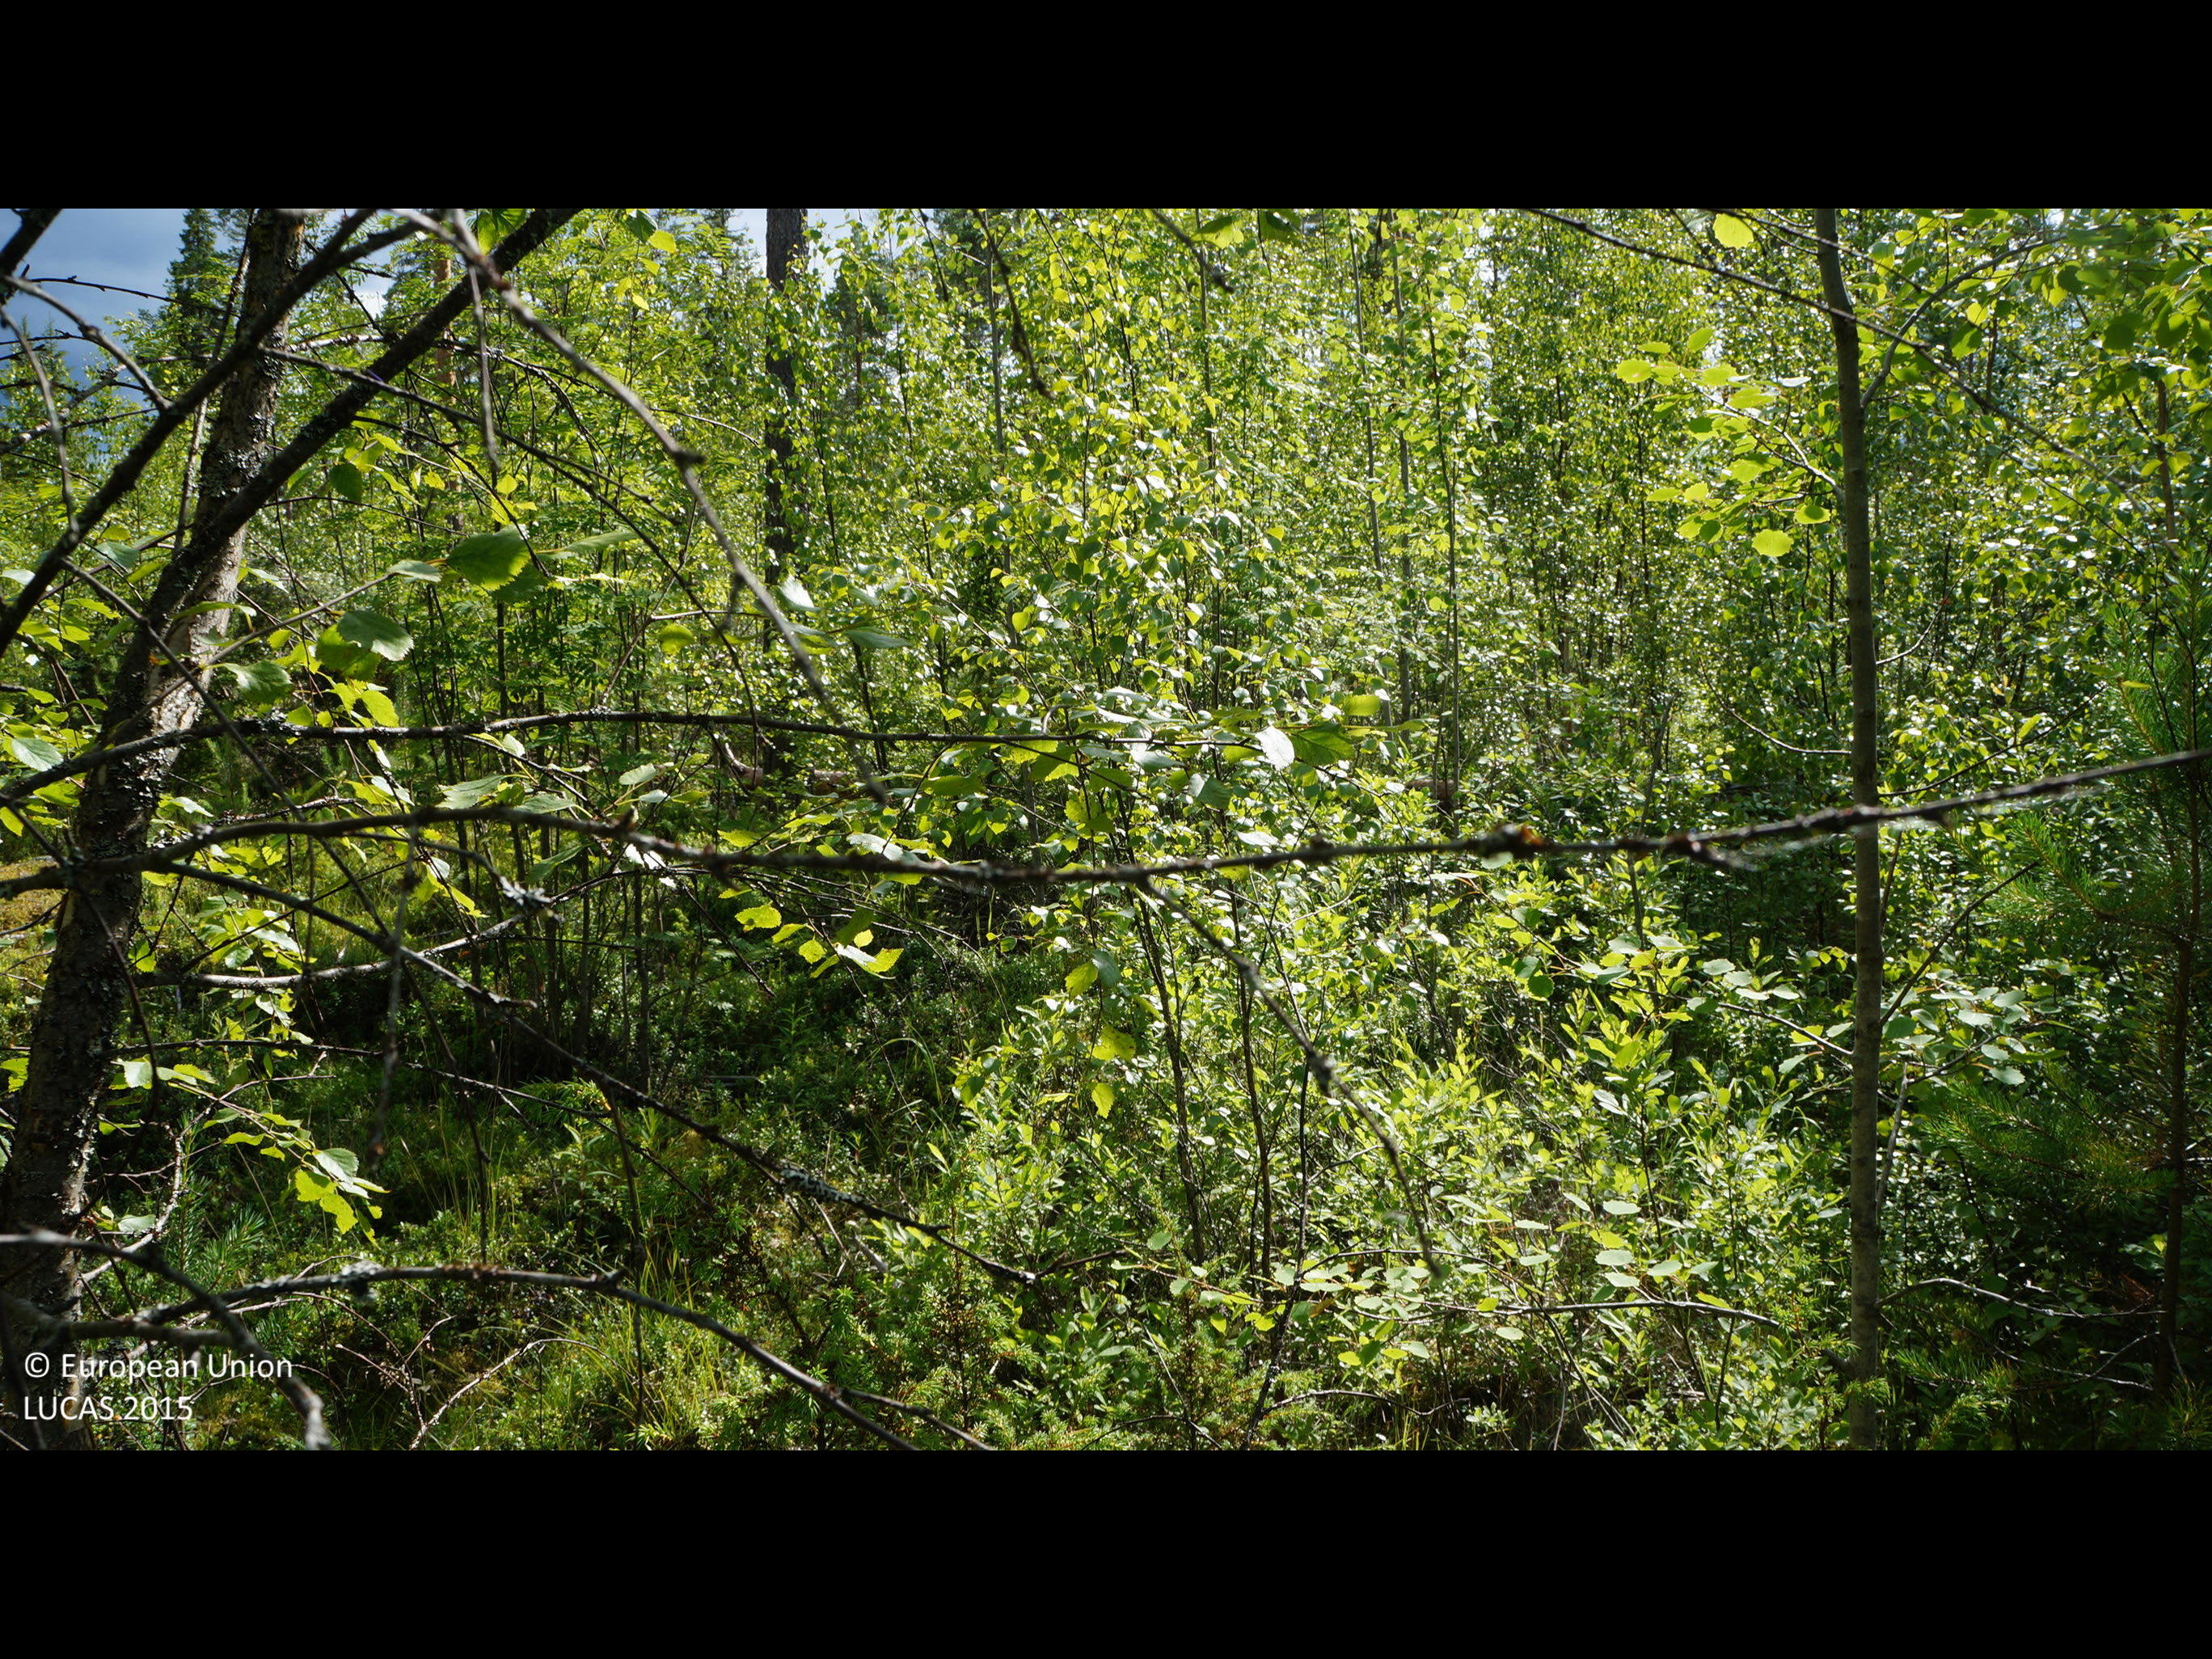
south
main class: Woodland
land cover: Pine dominated mixed woodland
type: boreal forest
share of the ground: 50 - 75 %
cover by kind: shrubs 40 %, coniferous forest trees 25 %, broadleaved forest trees 25 %, herbaceous plants 5 %, lichens and mosses 5 %
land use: Forestry
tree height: > 5 m
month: July
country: FI
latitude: 64.0018
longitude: 24.3229
